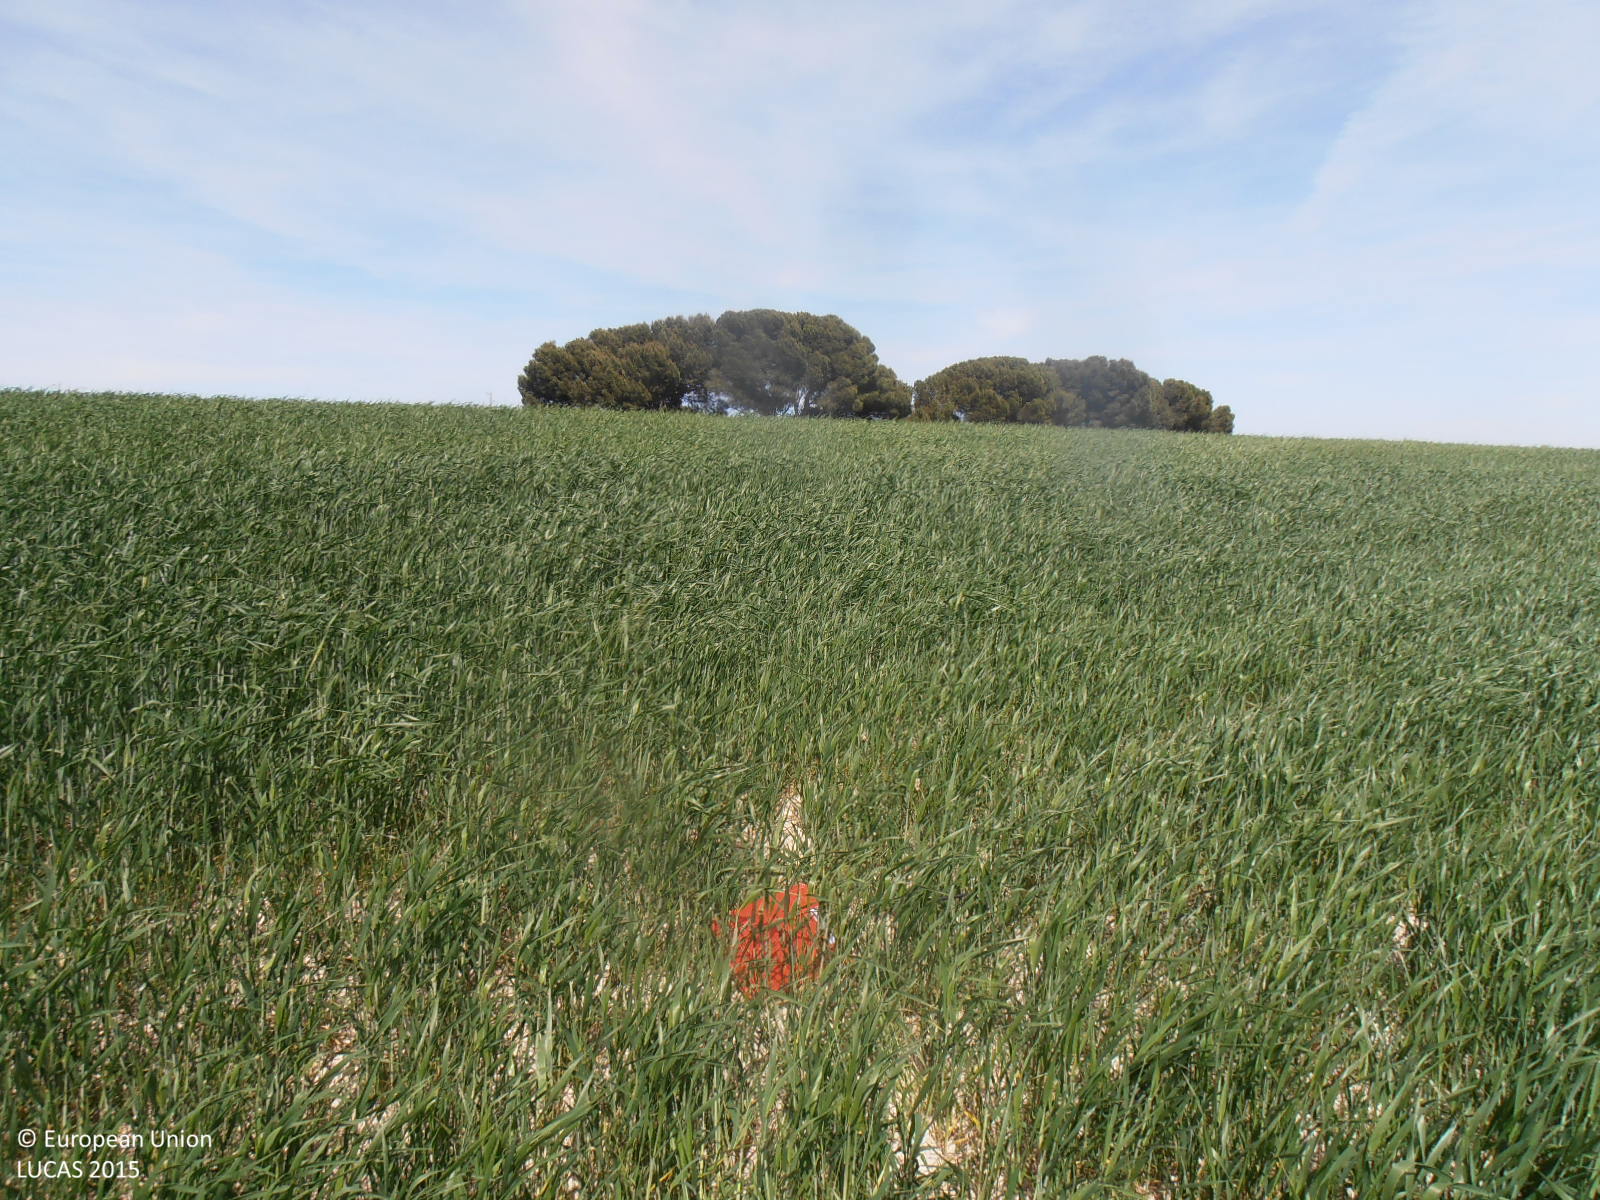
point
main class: Cropland
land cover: Durum wheat
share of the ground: > 75 %
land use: Agriculture (excluding fallow land and kitchen gardens)
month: April
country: ES
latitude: 41.3707
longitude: -0.9111
